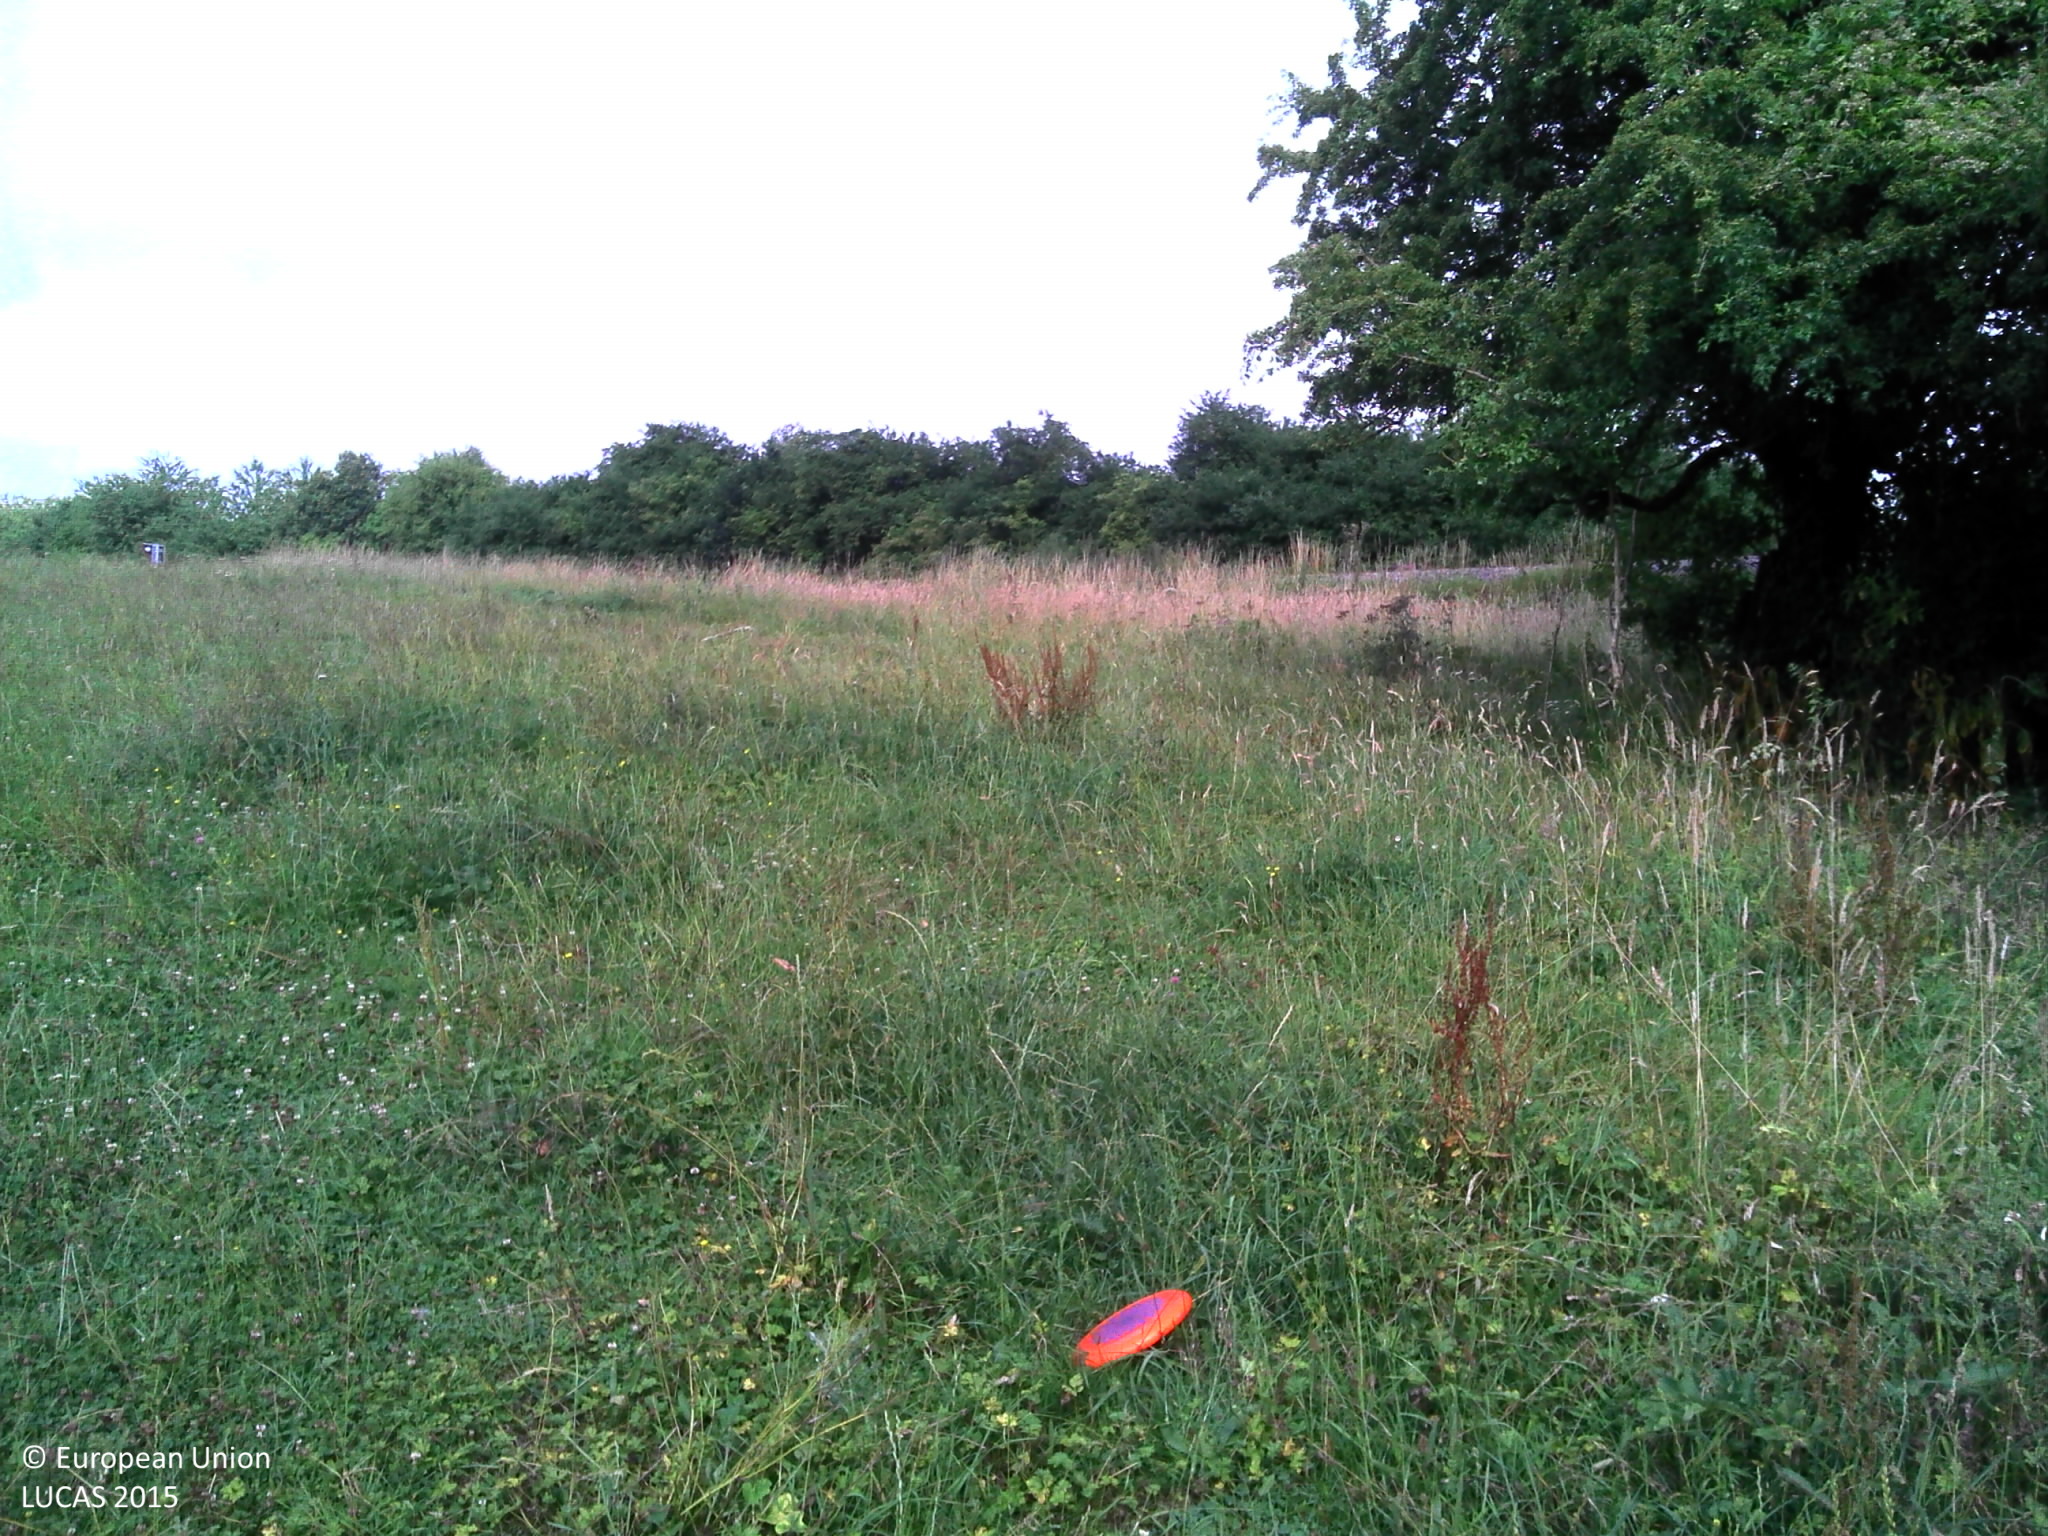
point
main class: Grassland
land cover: Grassland without tree/shrub cover
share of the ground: > 75 %
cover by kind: herbaceous plants 100 %
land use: Agriculture (excluding fallow land and kitchen gardens)
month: July
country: BE
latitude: 50.1787
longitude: 4.5207
